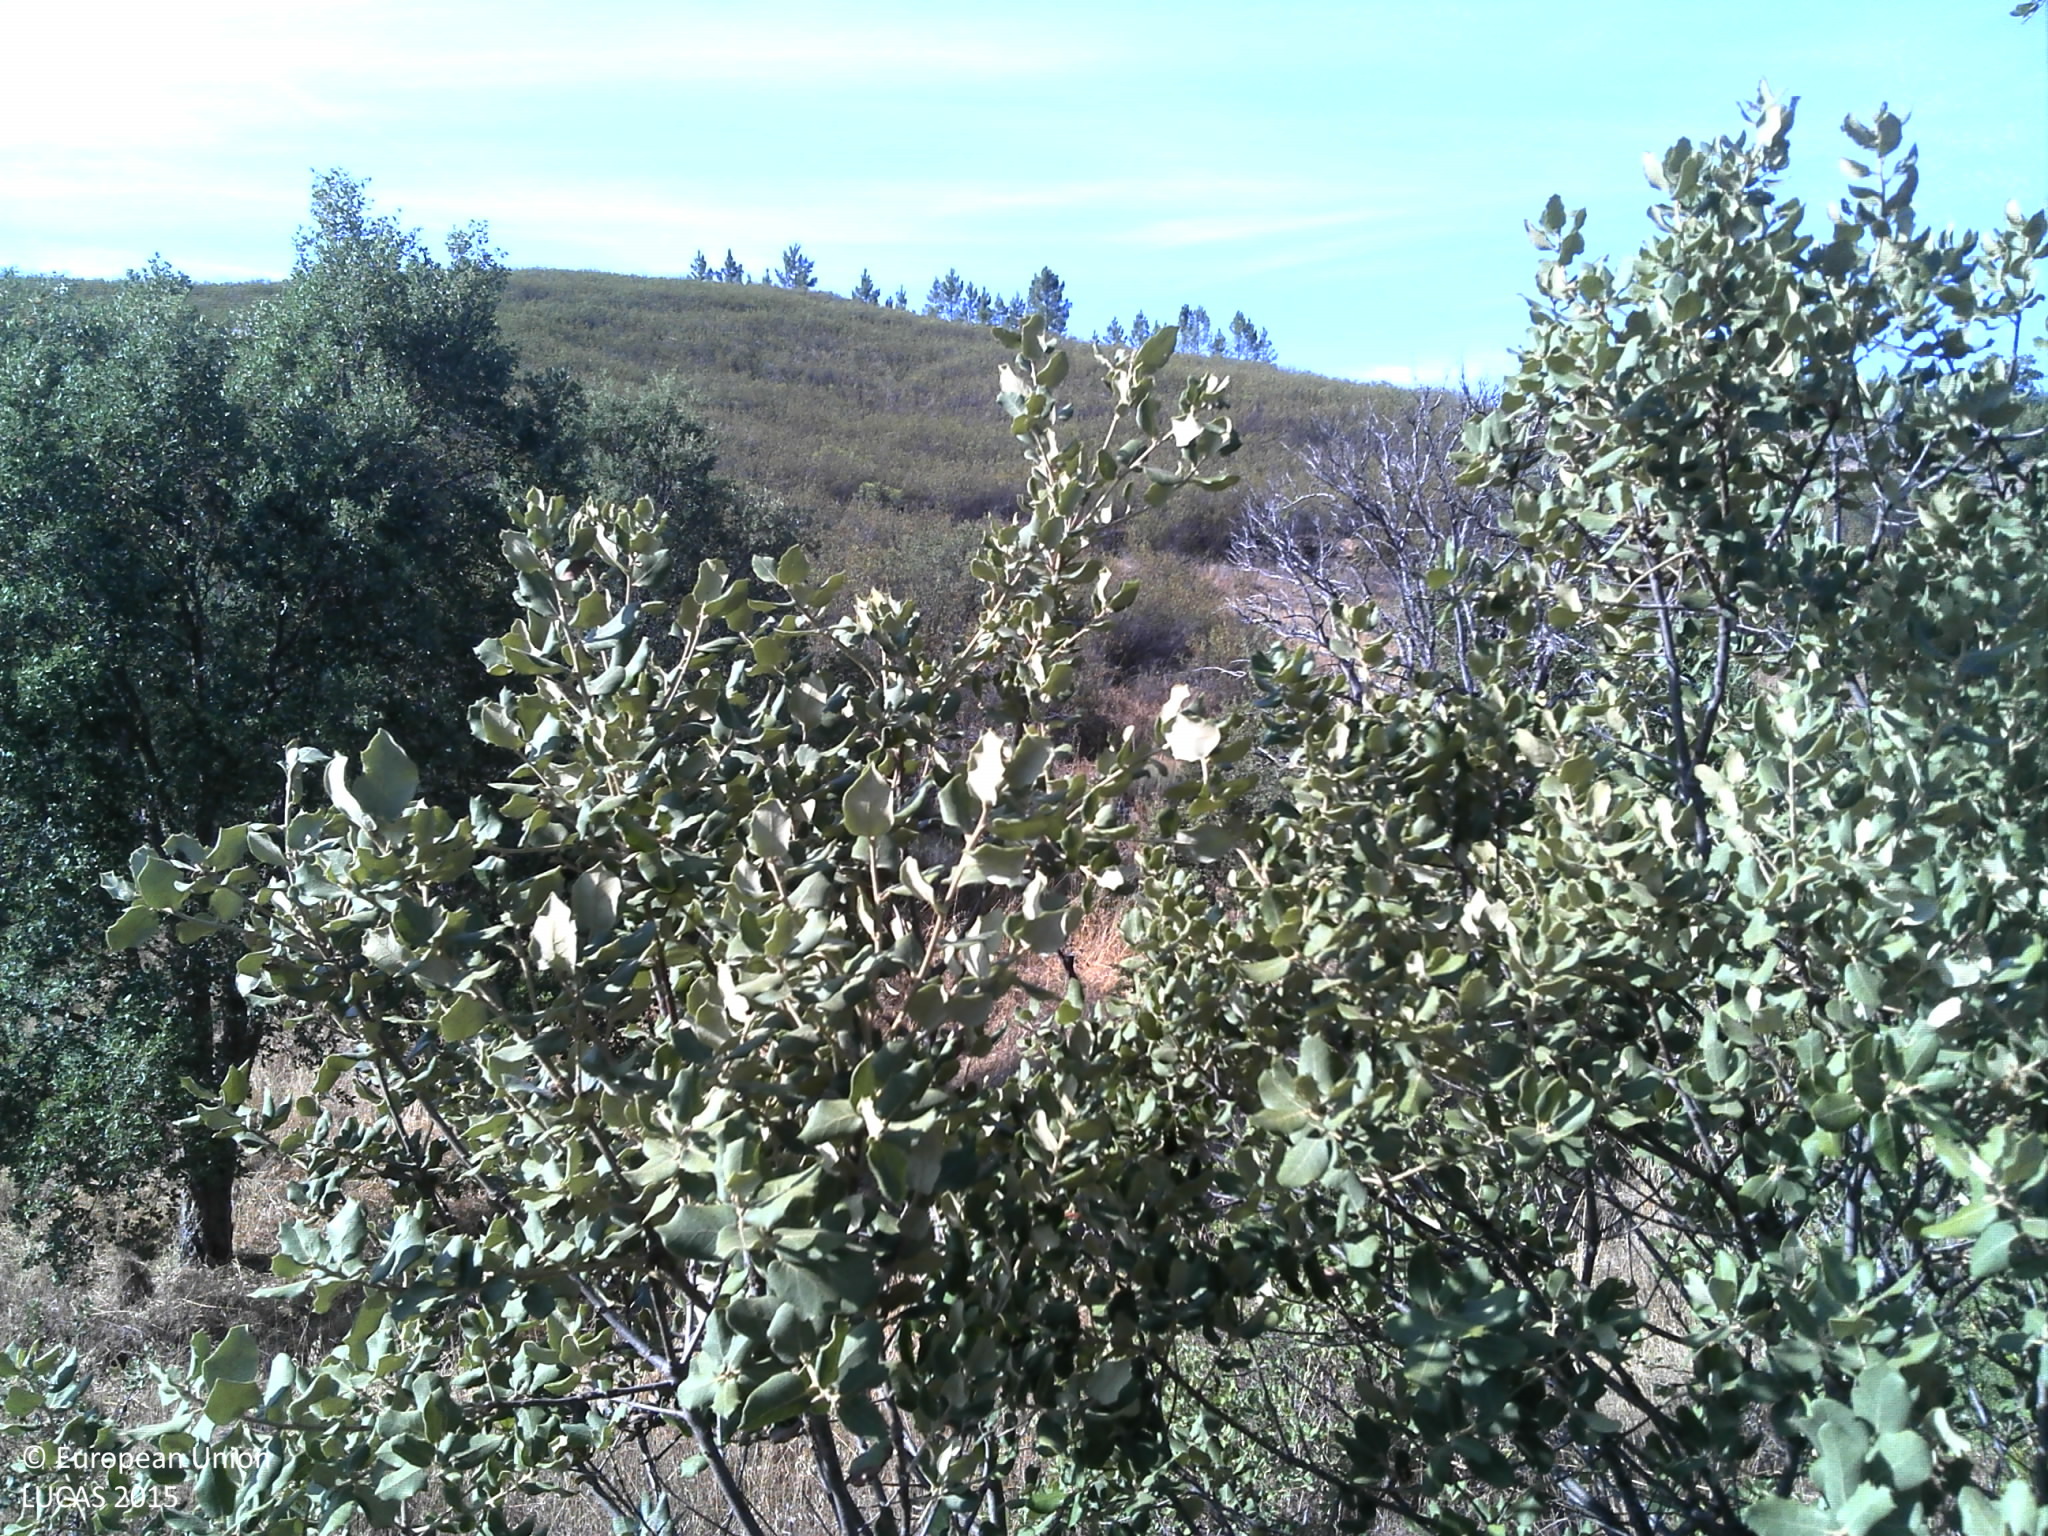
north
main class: Shrubland
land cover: Shrubland with sparse tree cover
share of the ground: > 75 %
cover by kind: shrubs 80 %, herbaceous plants 10 %, broadleaved forest trees 5 %, unconsolidated bare surface 5 %
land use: Semi-natural and natural areas not in use
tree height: < 5 m
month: July
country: PT
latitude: 39.6268
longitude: -7.7757
